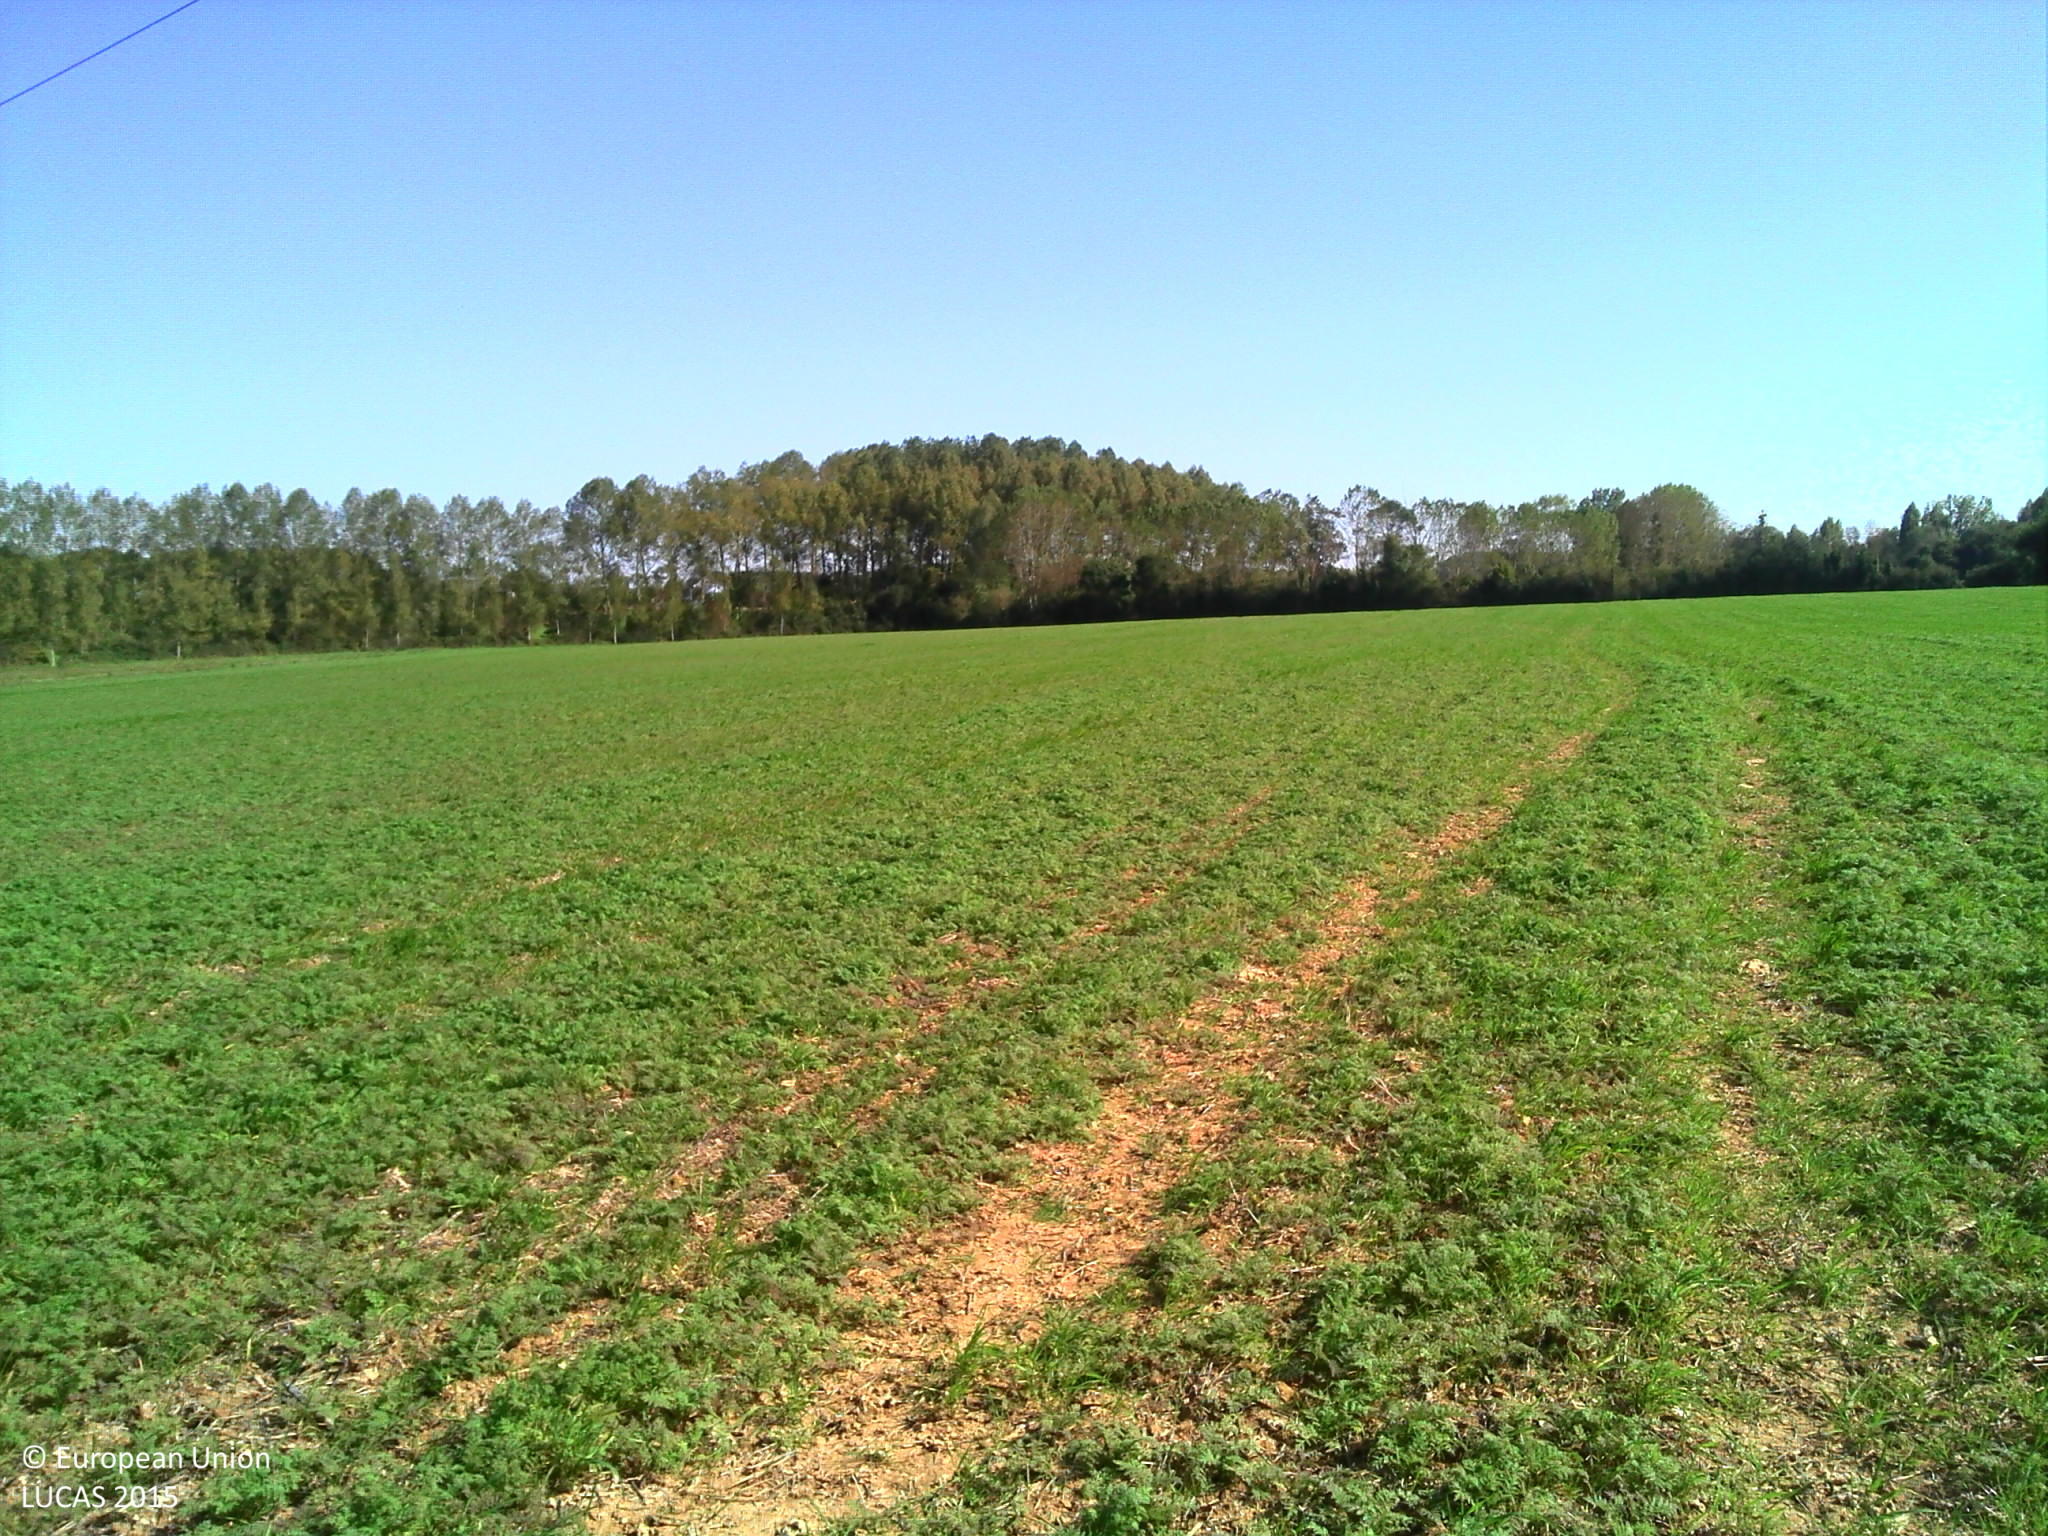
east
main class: Cropland
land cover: Other leguminous and mixtures for fodder
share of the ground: 25 - 50 %
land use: Agriculture (excluding fallow land and kitchen gardens)
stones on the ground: < 10 %
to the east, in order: Other leguminous and mixtures for fodder; Electric lines; Other leguminous and mixtures for fodder
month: September
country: FR
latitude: 46.5318
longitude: -1.1287
